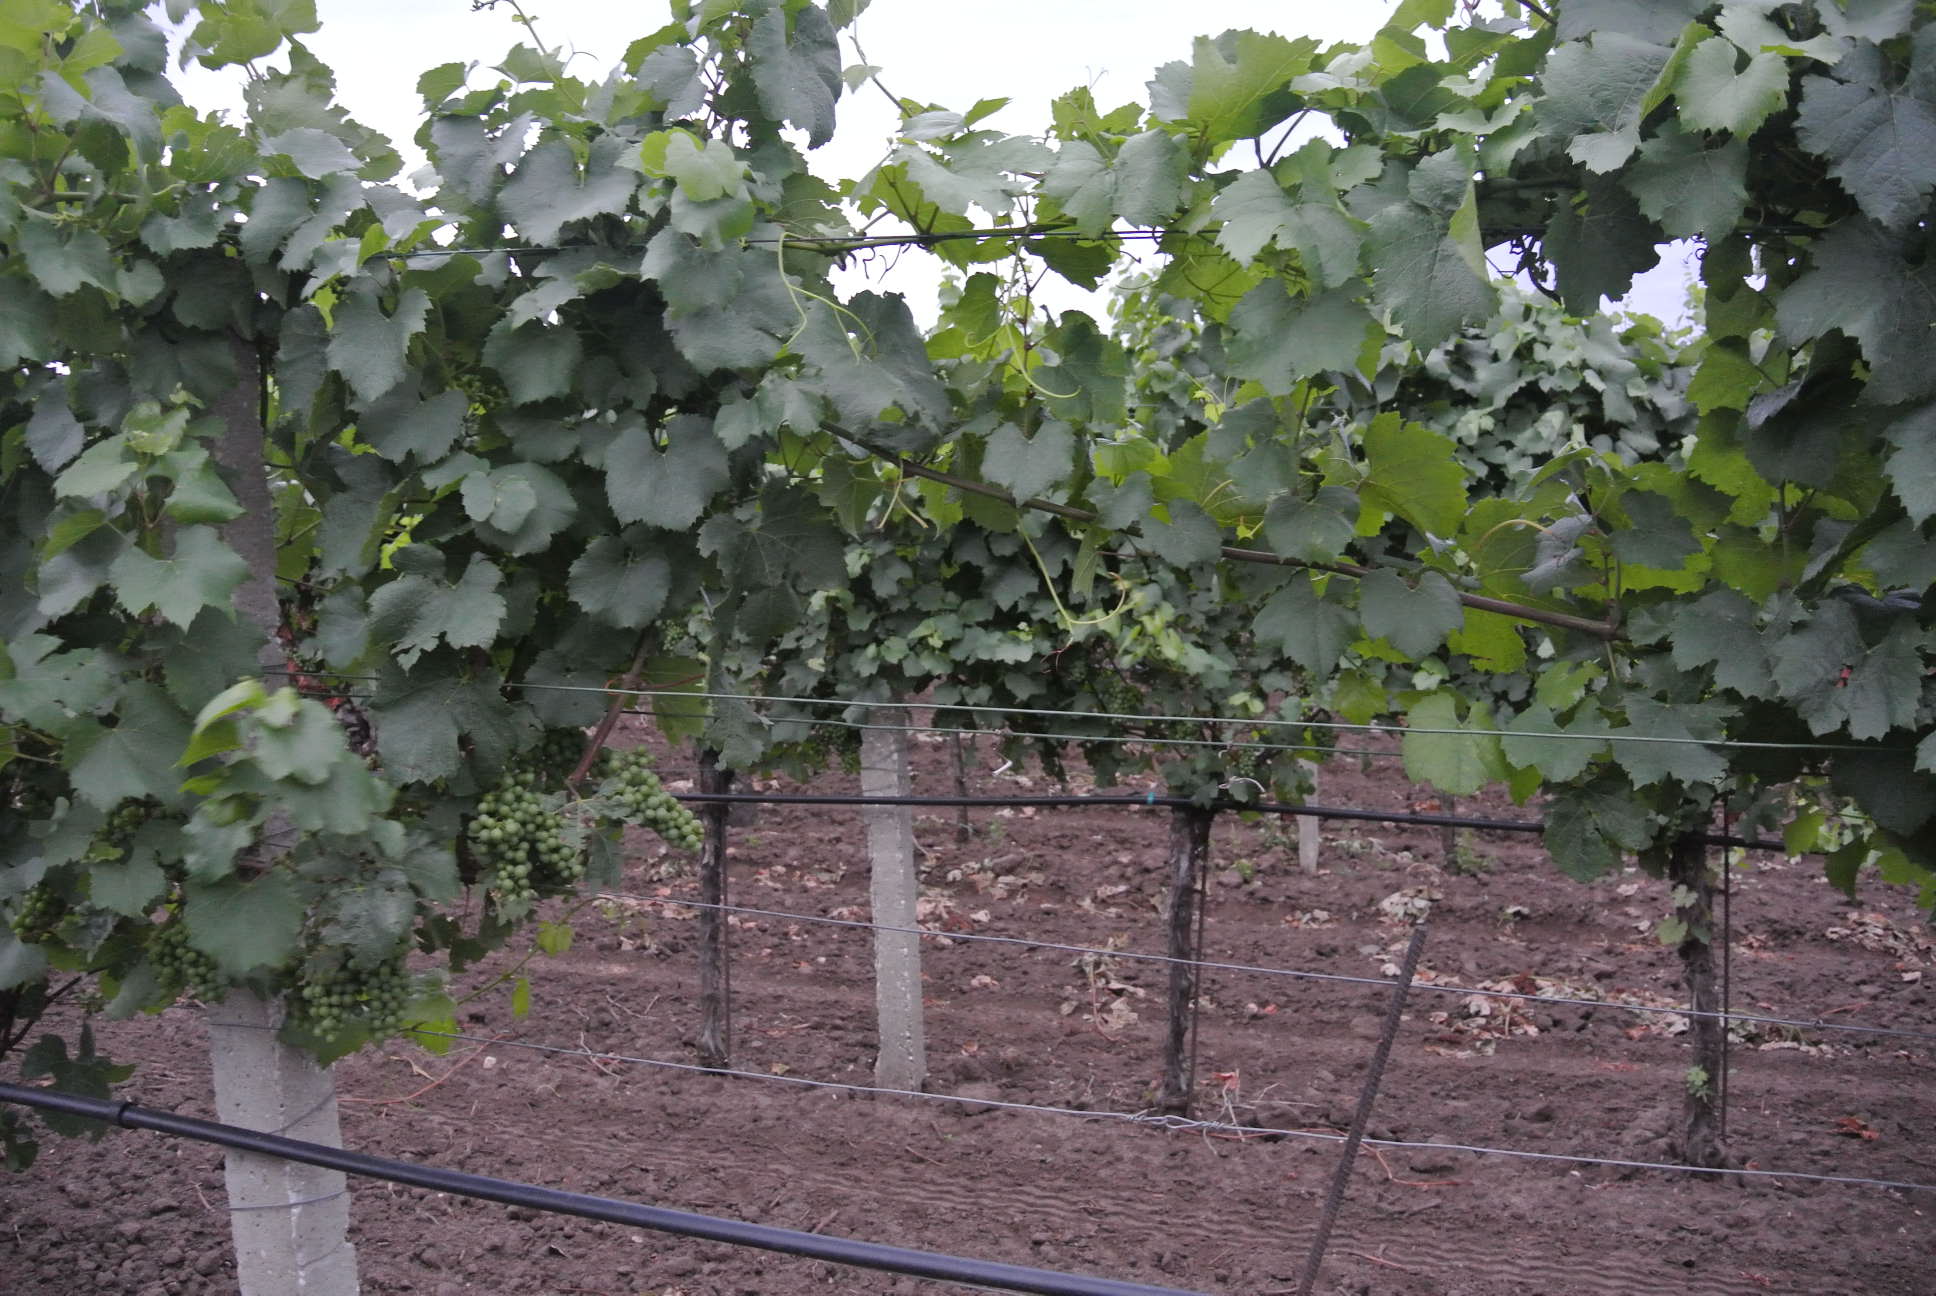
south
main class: Cropland
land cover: Vineyards
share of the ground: 25 - 50 %
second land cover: Other bare soil
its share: > 75 %
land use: Agriculture (excluding fallow land and kitchen gardens)
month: July
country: AT
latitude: 47.7967
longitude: 16.8011
